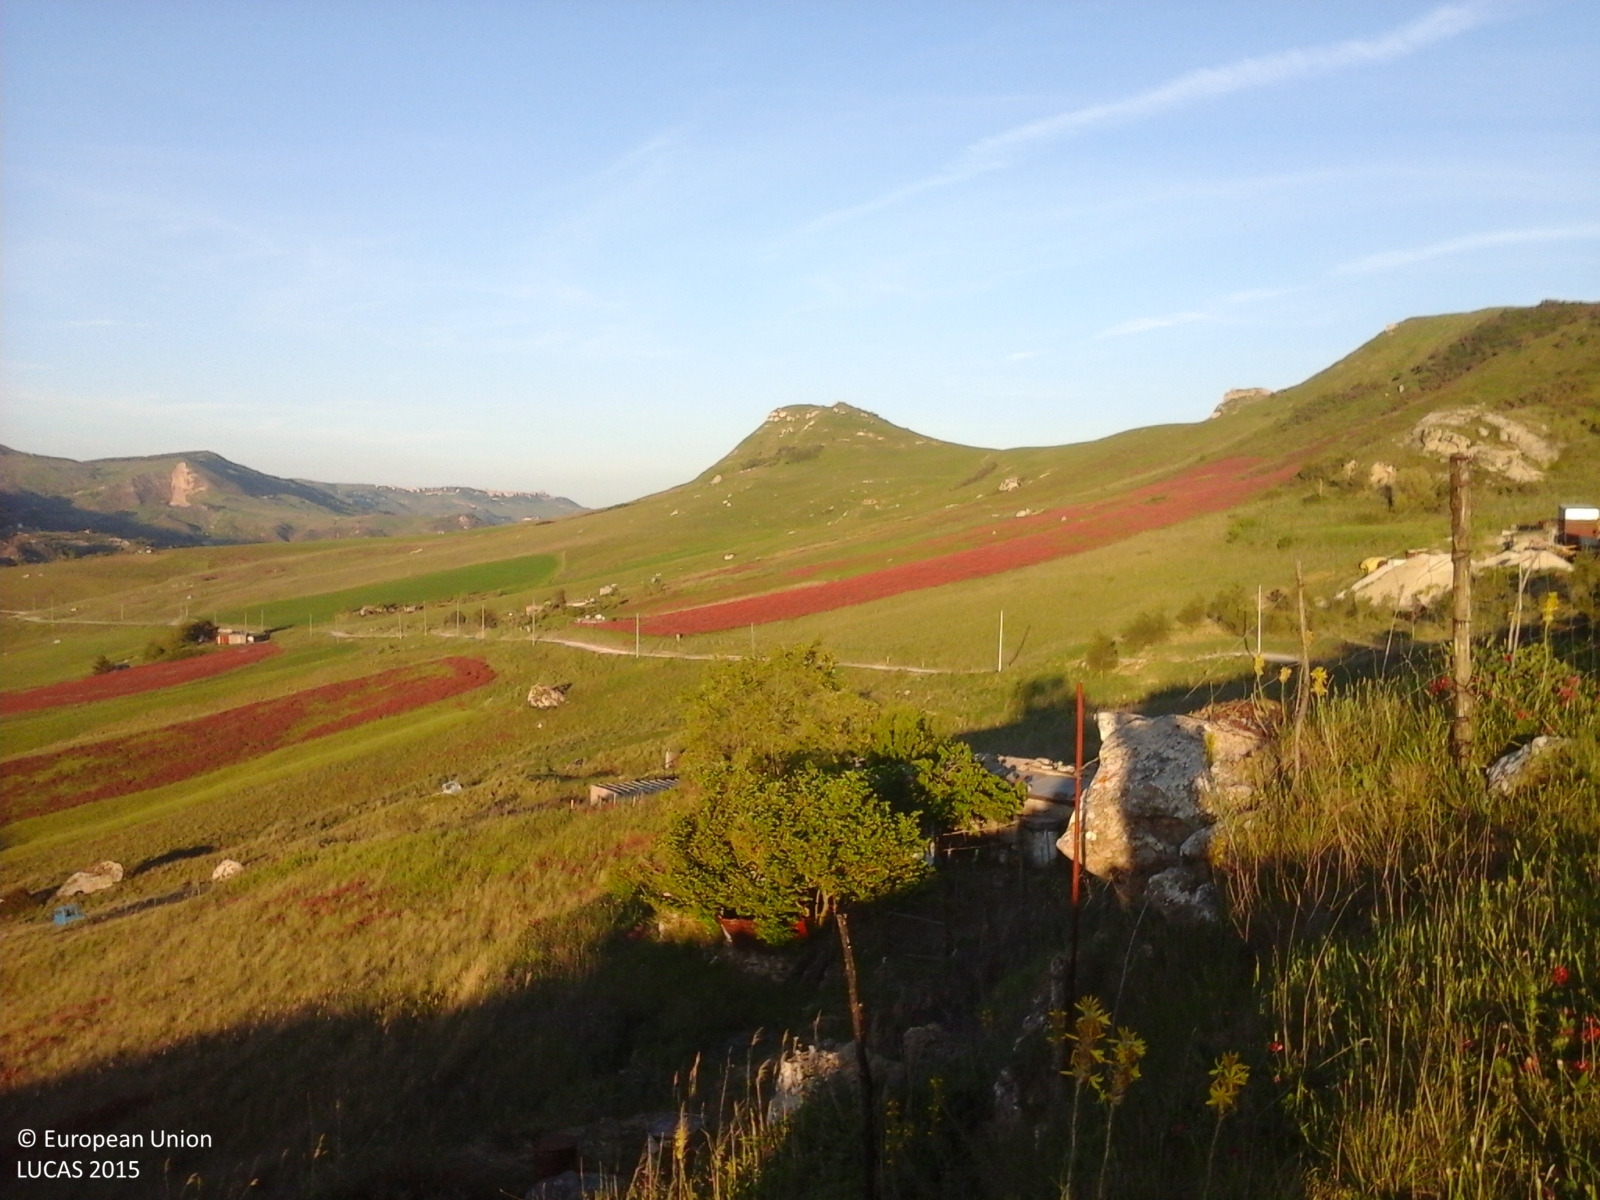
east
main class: Grassland
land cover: Grassland without tree/shrub cover
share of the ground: > 75 %
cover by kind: herbaceous plants 100 %
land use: Agriculture (excluding fallow land and kitchen gardens)
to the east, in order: Grassland without tree/shrub cover; Fences; Grassland without tree/shrub cover; Fences; Spontaneously vegetated surfaces; Fences; Grassland without tree/shrub cover; Tracks; Grassland with sparse tree/shrub cover; Fences; Grassland without tree/shrub cover; Electric lines; Grass margins; Paved roads, cycling and walking lanes
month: May
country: IT
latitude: 37.7905
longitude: 14.0025
